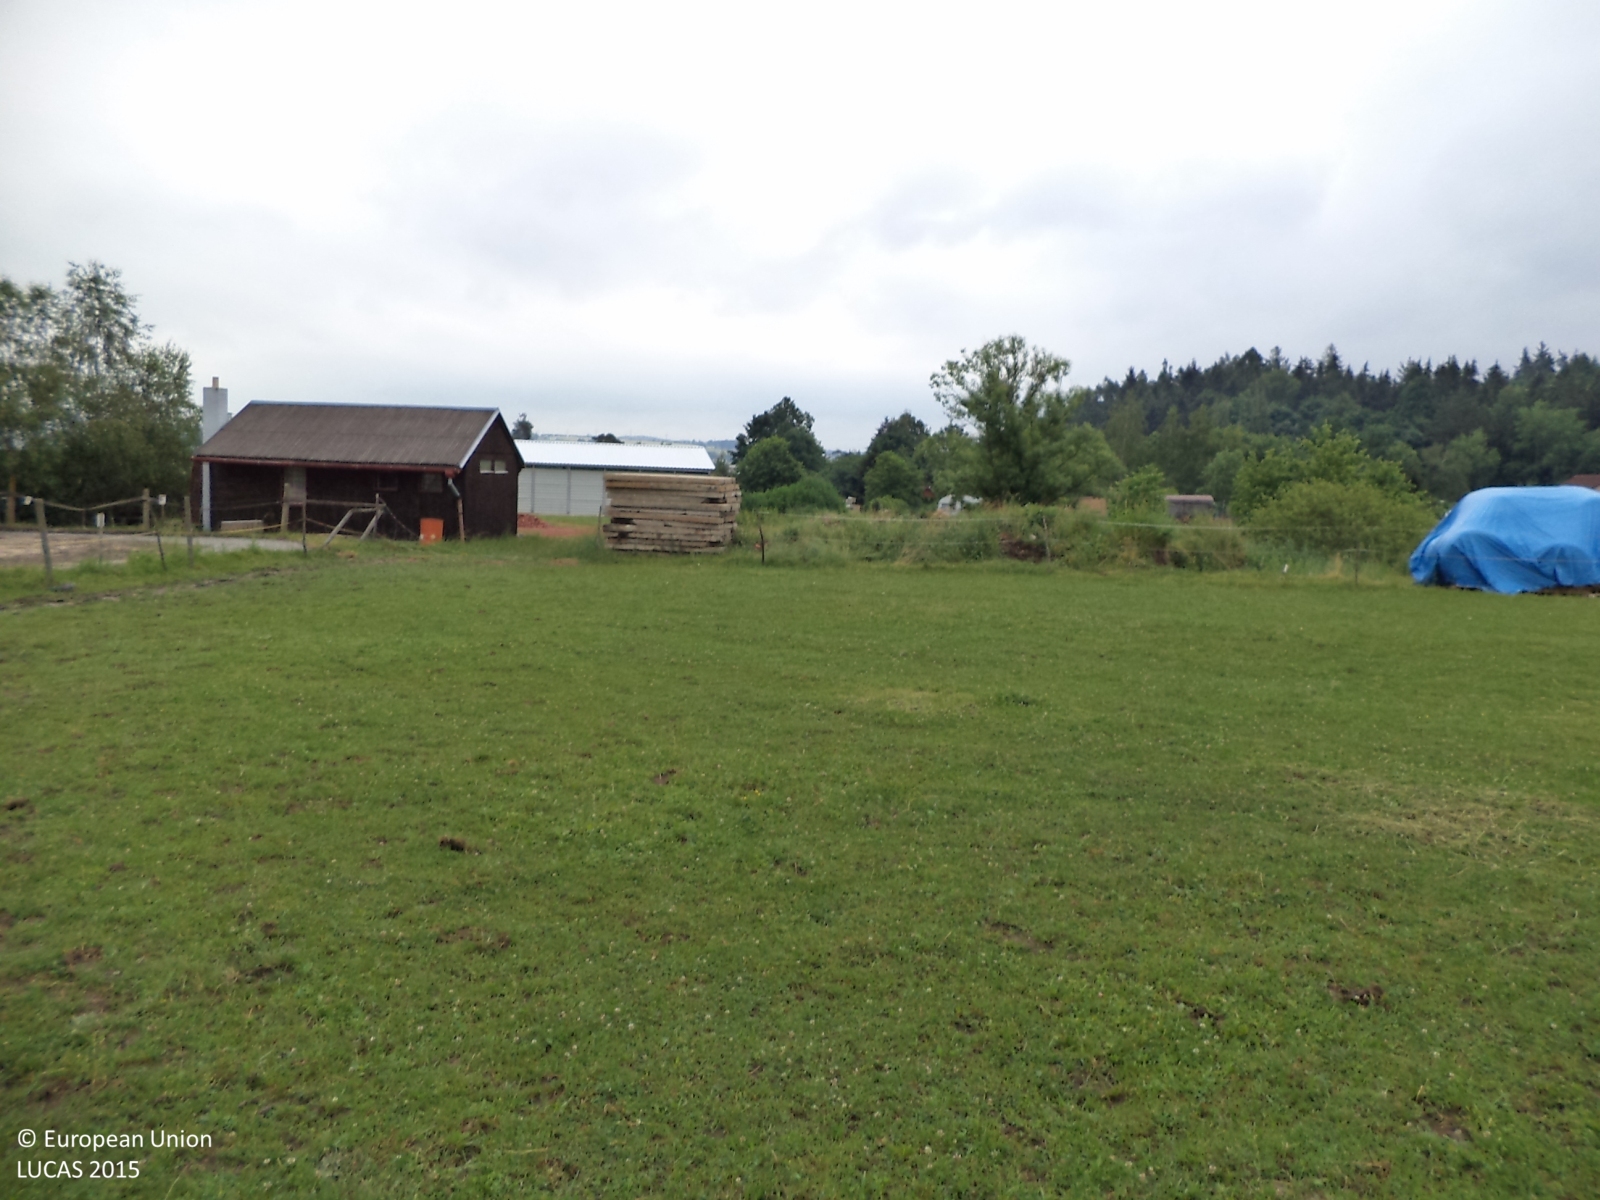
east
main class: Grassland
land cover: Grassland without tree/shrub cover
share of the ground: > 75 %
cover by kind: herbaceous plants 100 %
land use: Agriculture (excluding fallow land and kitchen gardens)
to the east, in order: Grassland without tree/shrub cover; Fences; Grassland with sparse tree/shrub cover; Tracks; Grassland without tree/shrub cover; Tracks; Grassland without tree/shrub cover; Artificial constructions in urban areas
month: June
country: CZ
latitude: 49.2165
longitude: 14.4080
